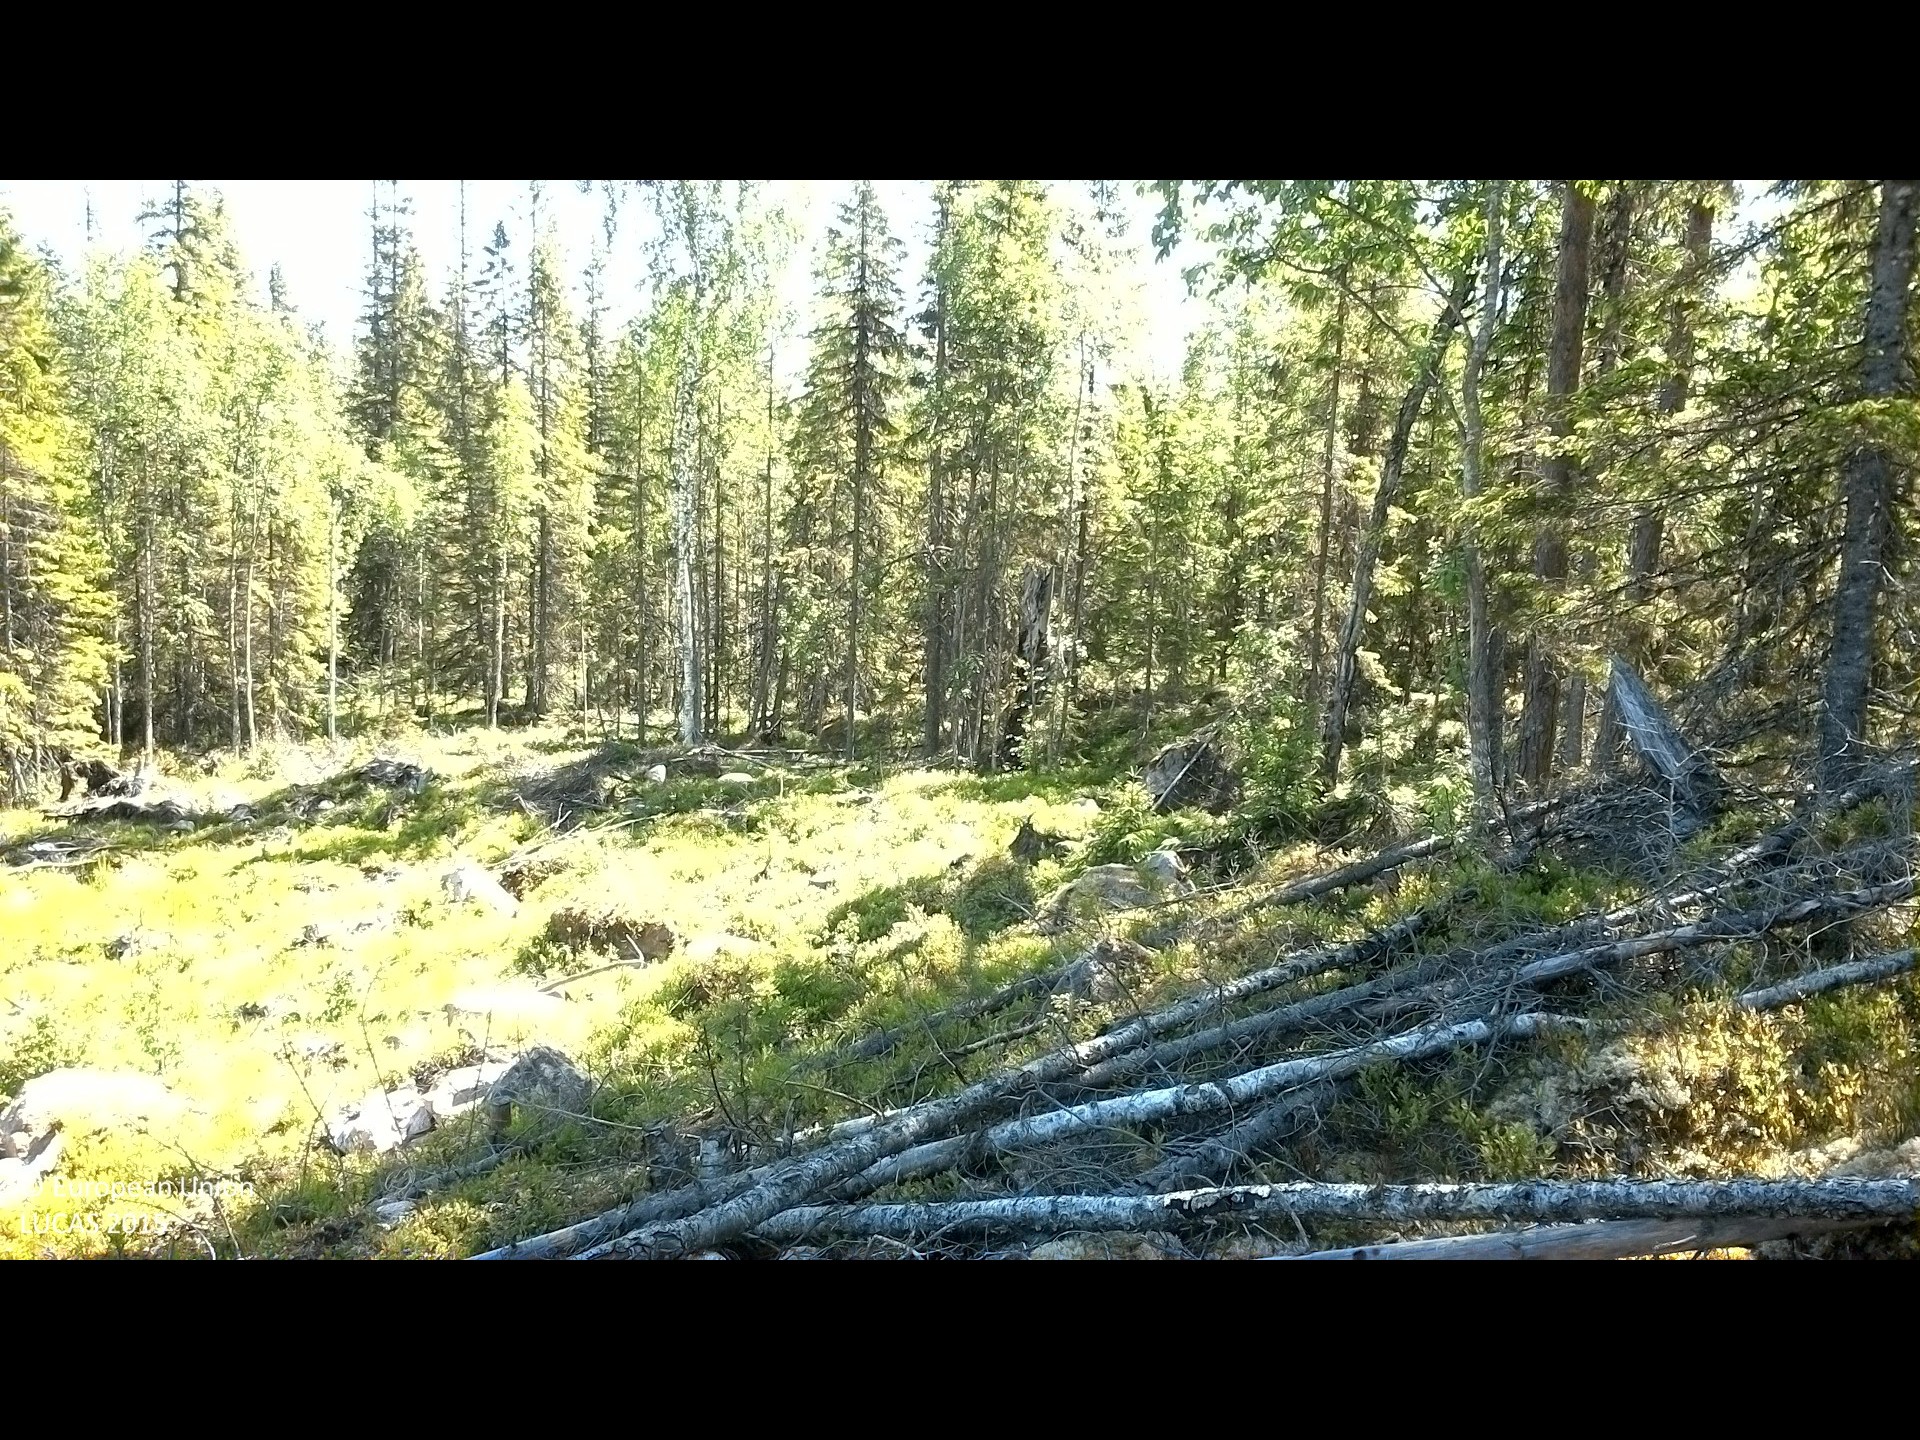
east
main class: Woodland
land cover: Spruce dominated coniferous woodland
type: boreal forest
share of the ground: 10 - 25 %
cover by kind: shrubs 55 %, coniferous forest trees 20 %, lichens and mosses 20 %, broadleaved forest trees 5 %
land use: Forestry
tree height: > 5 m
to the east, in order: Spruce dominated coniferous woodland; Shrubland with sparse tree cover; Spruce dominated mixed woodland; Rivers and streams; Spruce dominated mixed woodland; Broadleaved woodland; Shrubland with sparse tree cover
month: June
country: SE
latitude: 62.0148
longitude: 16.1900
